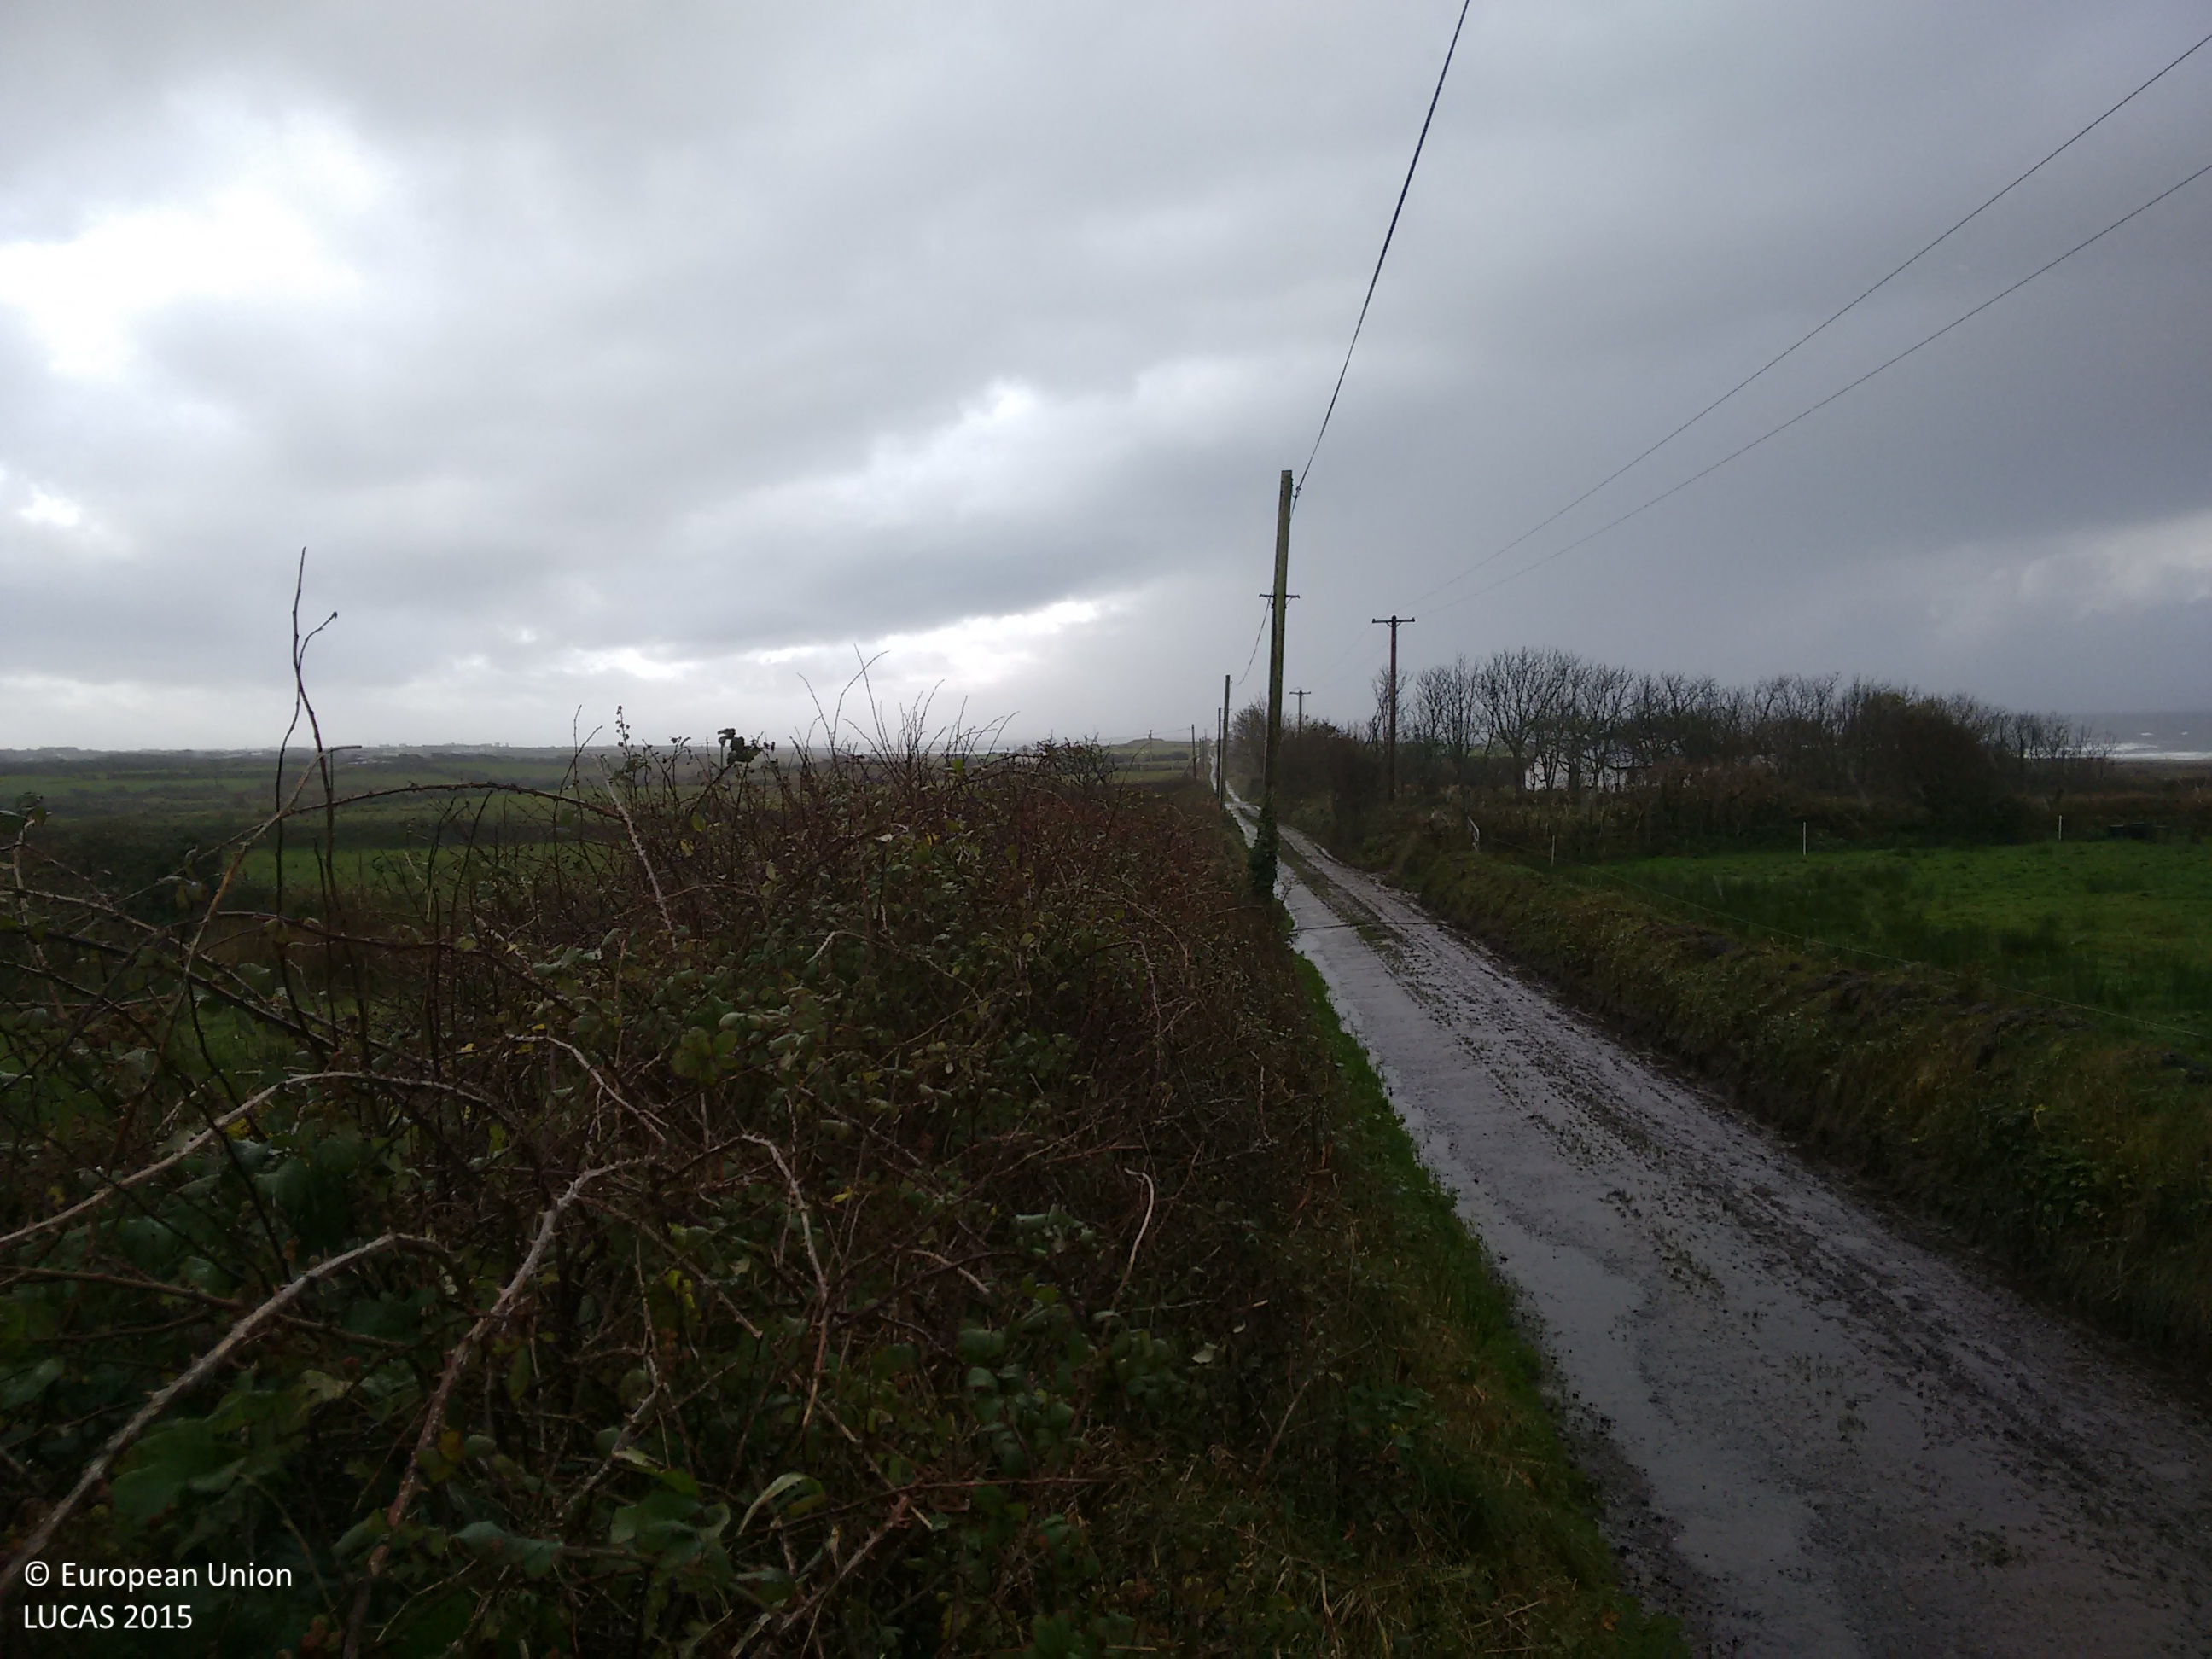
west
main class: Grassland
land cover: Grassland without tree/shrub cover
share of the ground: > 75 %
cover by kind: herbaceous plants 100 %
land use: Agriculture (excluding fallow land and kitchen gardens)
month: November
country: IE
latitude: 54.3880
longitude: -8.5653
